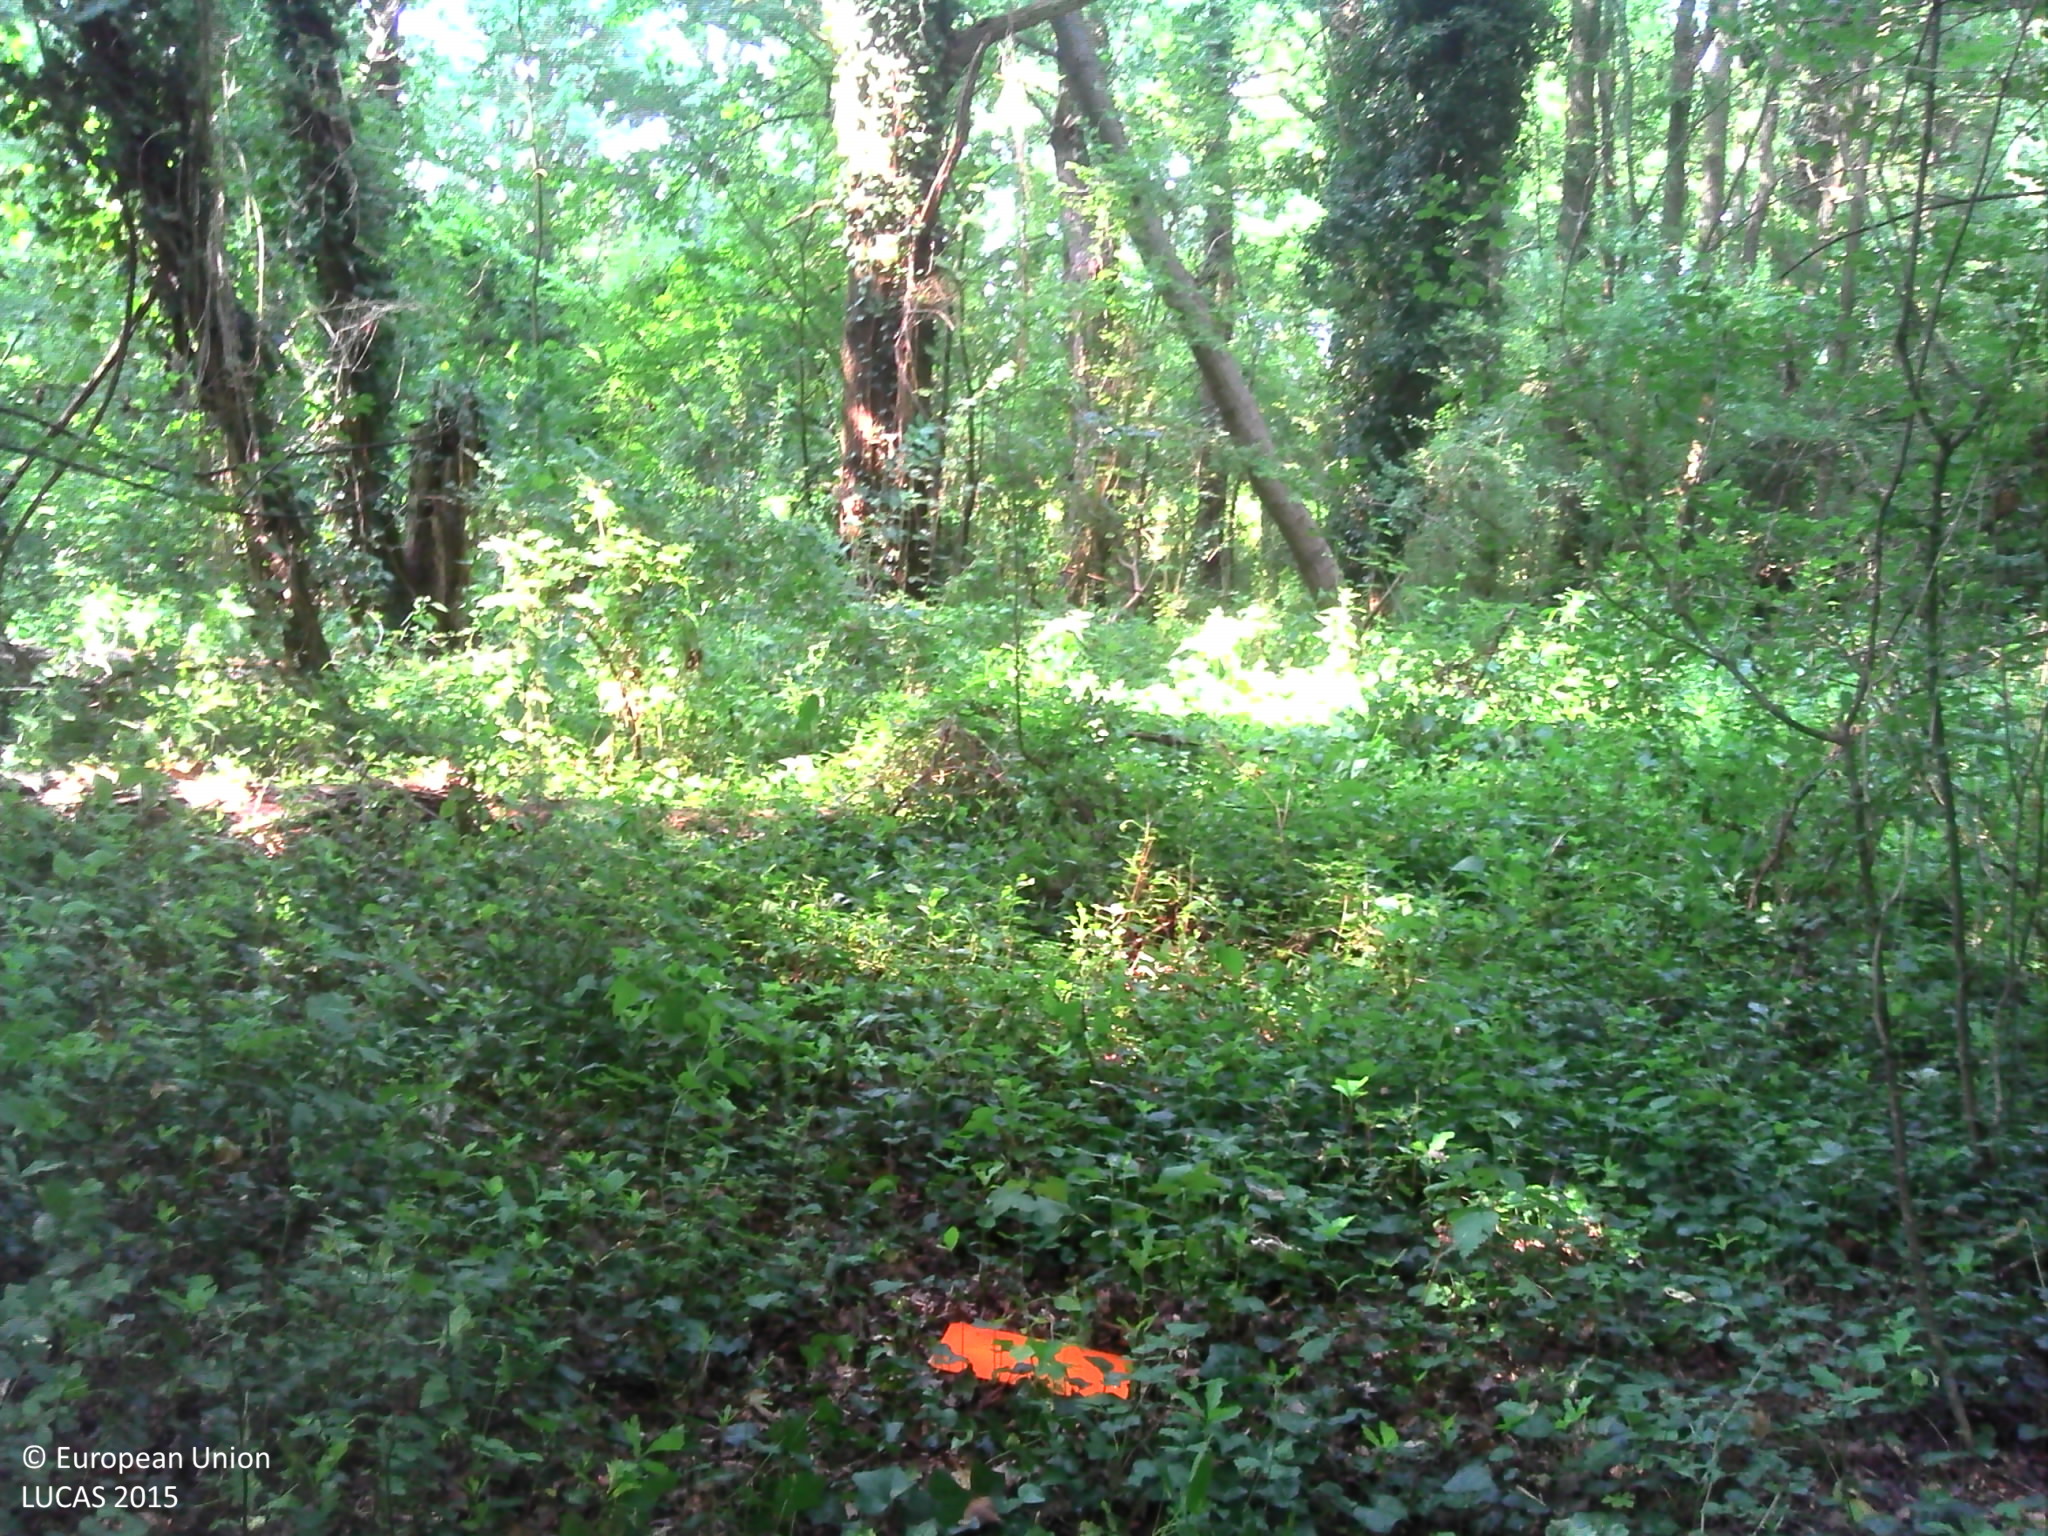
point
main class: Woodland
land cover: Broadleaved woodland
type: mesophytic deciduous forest
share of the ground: > 75 %
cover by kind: broadleaved forest trees 80 %, herbaceous plants 10 %, shrubs 5 %, lichens and mosses 5 %
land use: Forestry
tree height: > 5 m
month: July
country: FR
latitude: 47.2136
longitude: 0.0864
